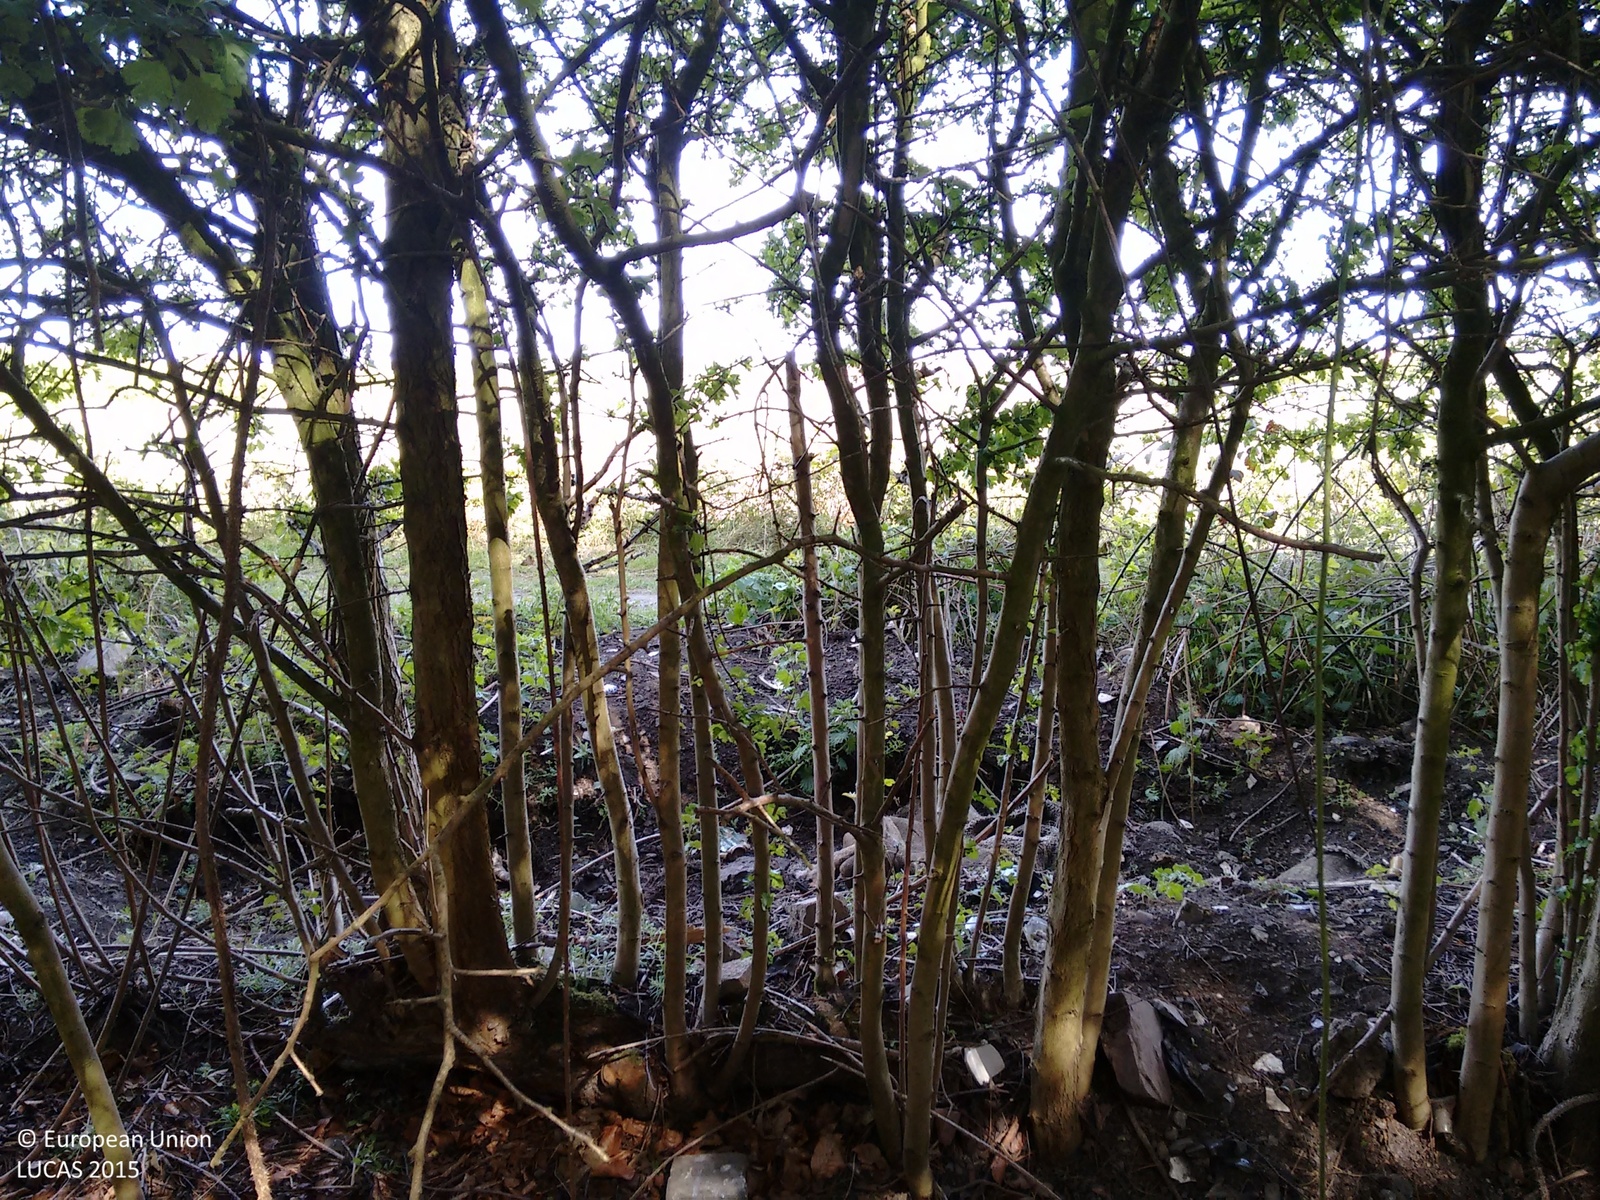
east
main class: Woodland
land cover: Other mixed woodland
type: hemiboreal forest and nemoral coniferous forest and mixed broadleaved-coniferous forest
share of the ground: > 75 %
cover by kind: broadleaved forest trees 70 %, coniferous forest trees 30 %
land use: Forestry
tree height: > 5 m
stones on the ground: < 10 %
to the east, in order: Other mixed woodland; Tracks; Grassland without tree/shrub cover; Barley
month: May
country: GB
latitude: 55.0842
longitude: -1.5305
